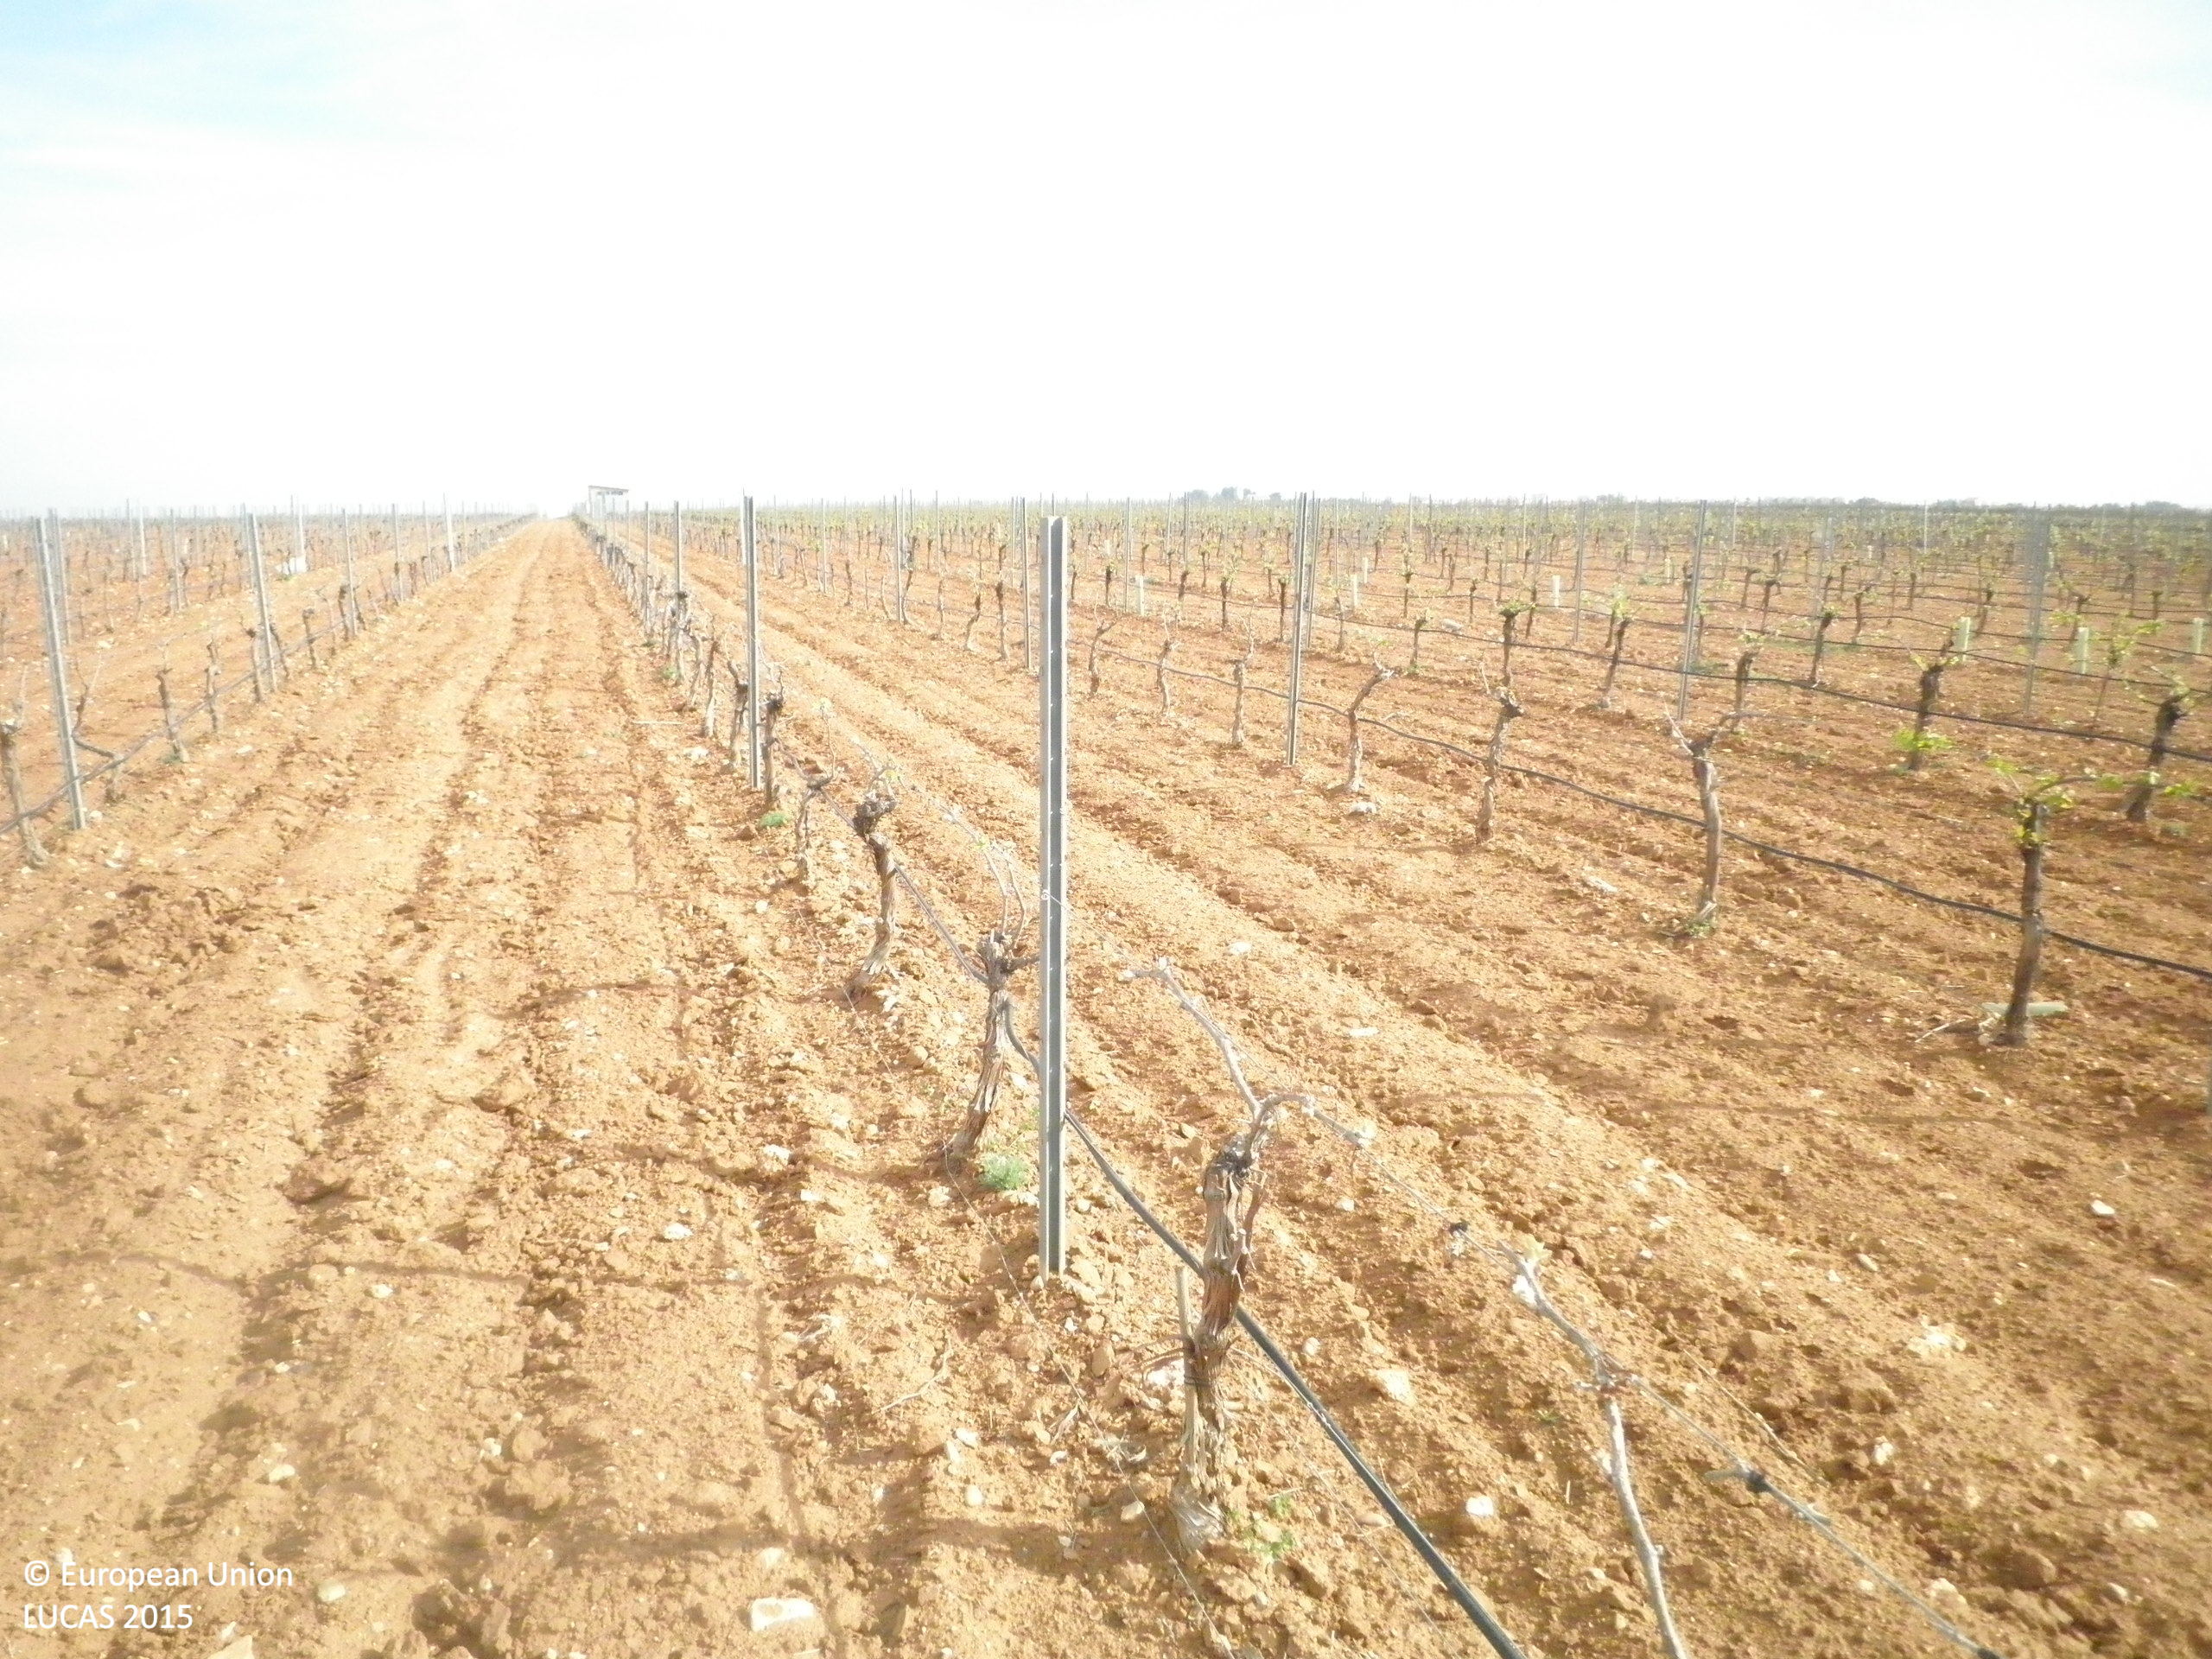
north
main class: Cropland
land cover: Vineyards
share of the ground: < 10 %
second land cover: Other bare soil
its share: > 75 %
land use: Agriculture (excluding fallow land and kitchen gardens)
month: April
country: ES
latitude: 39.3742
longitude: -2.7703
